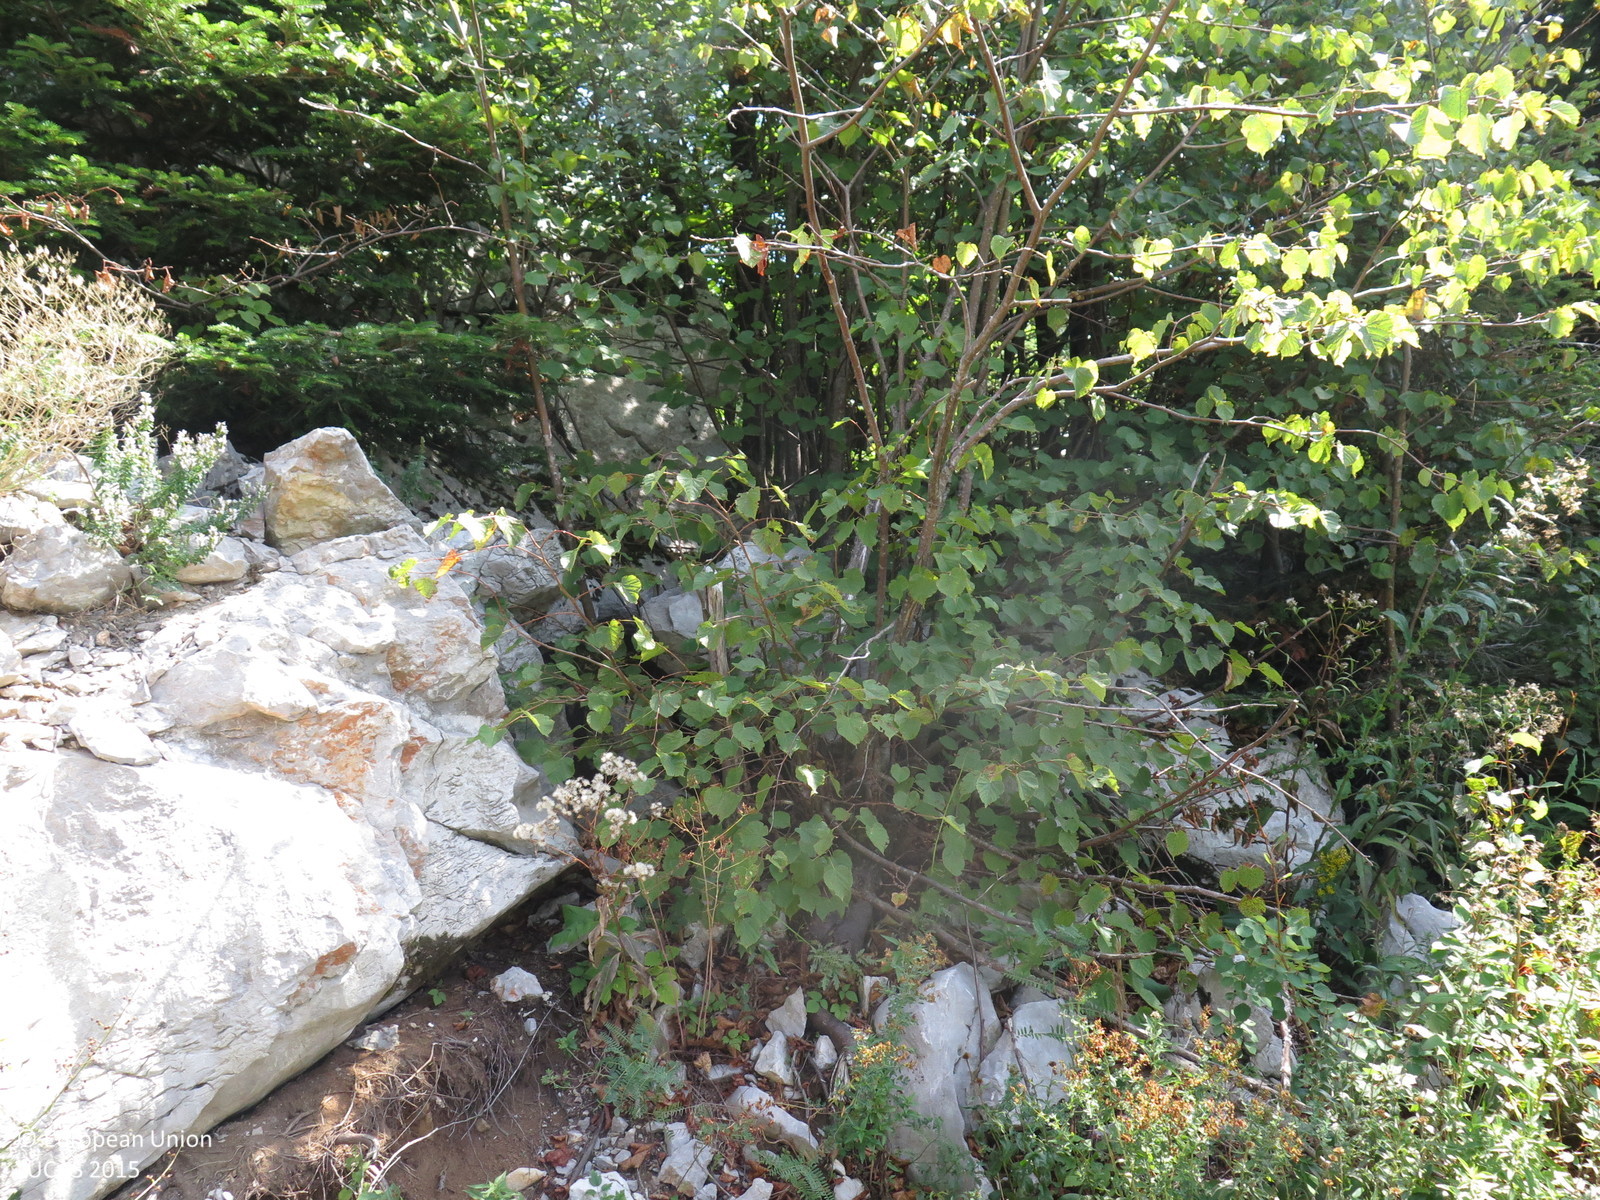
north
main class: Woodland
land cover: Broadleaved woodland
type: mesophytic deciduous forest
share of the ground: > 75 %
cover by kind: broadleaved forest trees 90 %, shrubs 5 %, herbaceous plants 5 %
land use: Semi-natural and natural areas not in use
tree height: > 5 m
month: August
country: HR
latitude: 45.2555
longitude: 14.6969
